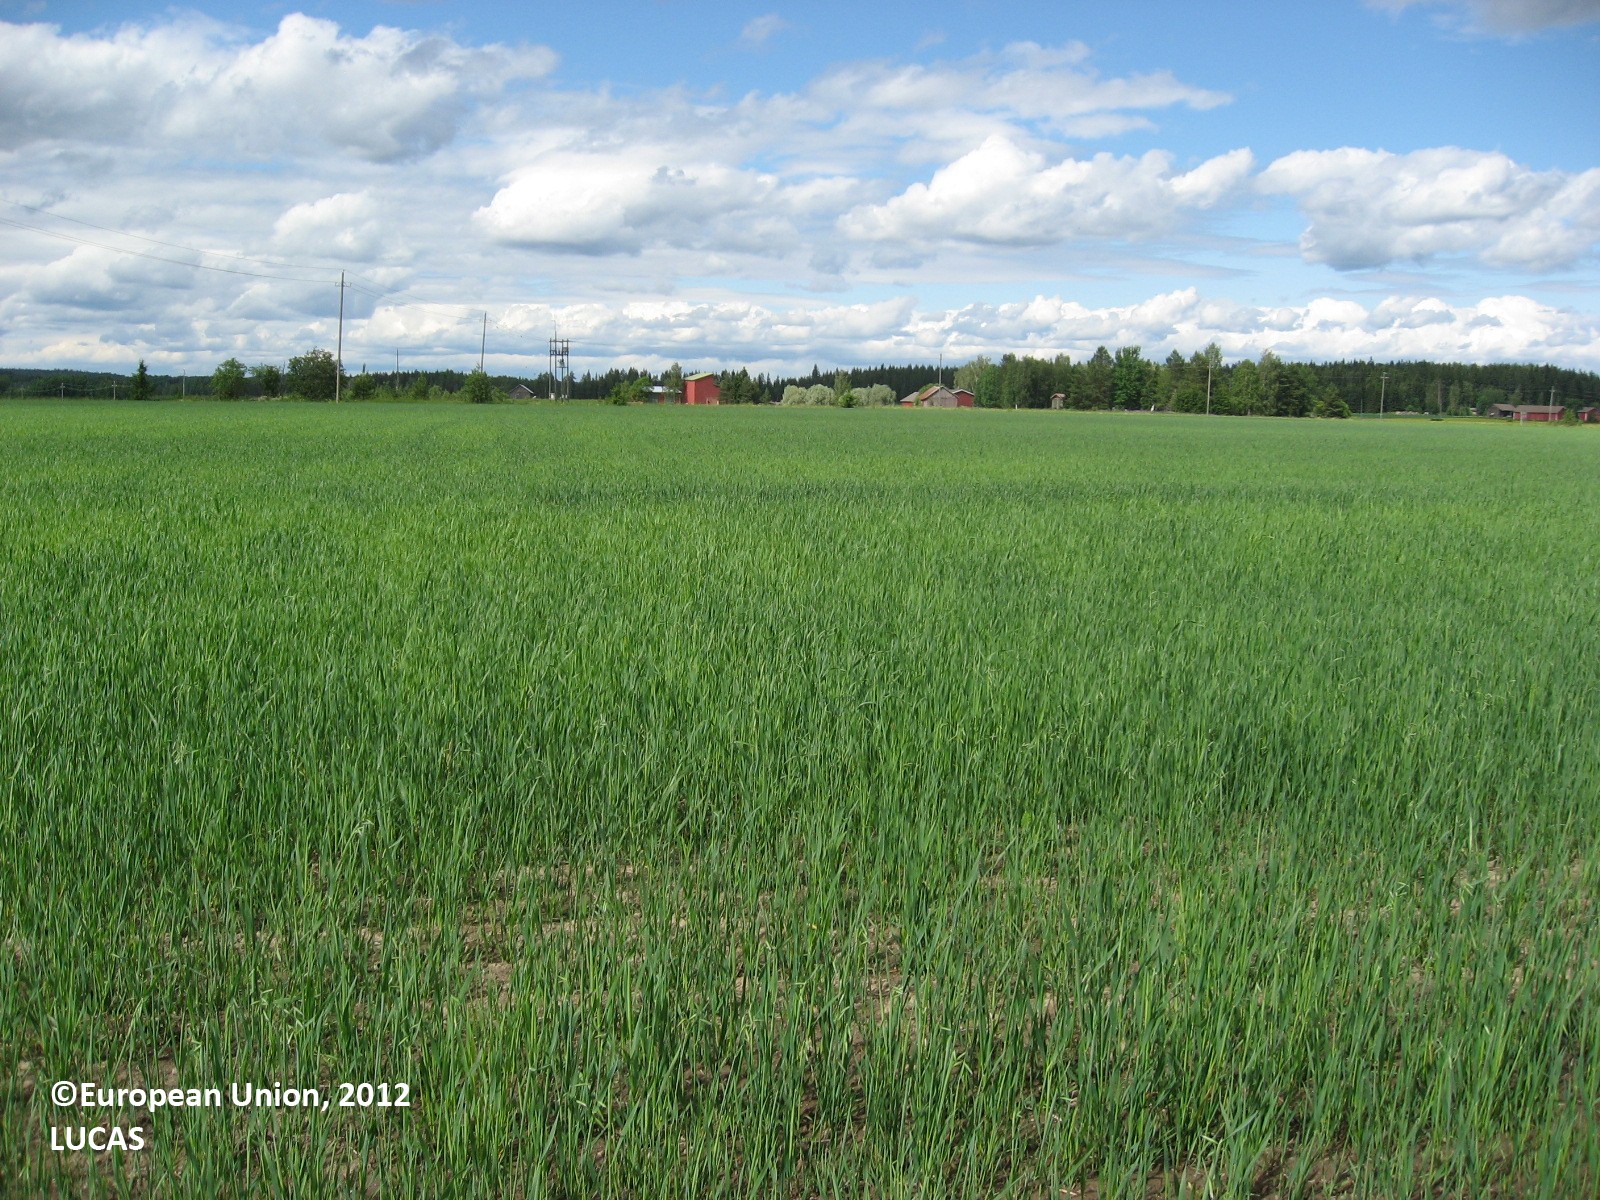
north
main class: Cropland
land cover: Oats
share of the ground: > 75 %
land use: Agriculture (excluding fallow land and kitchen gardens)
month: June
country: FI
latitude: 60.7707
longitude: 26.4739
